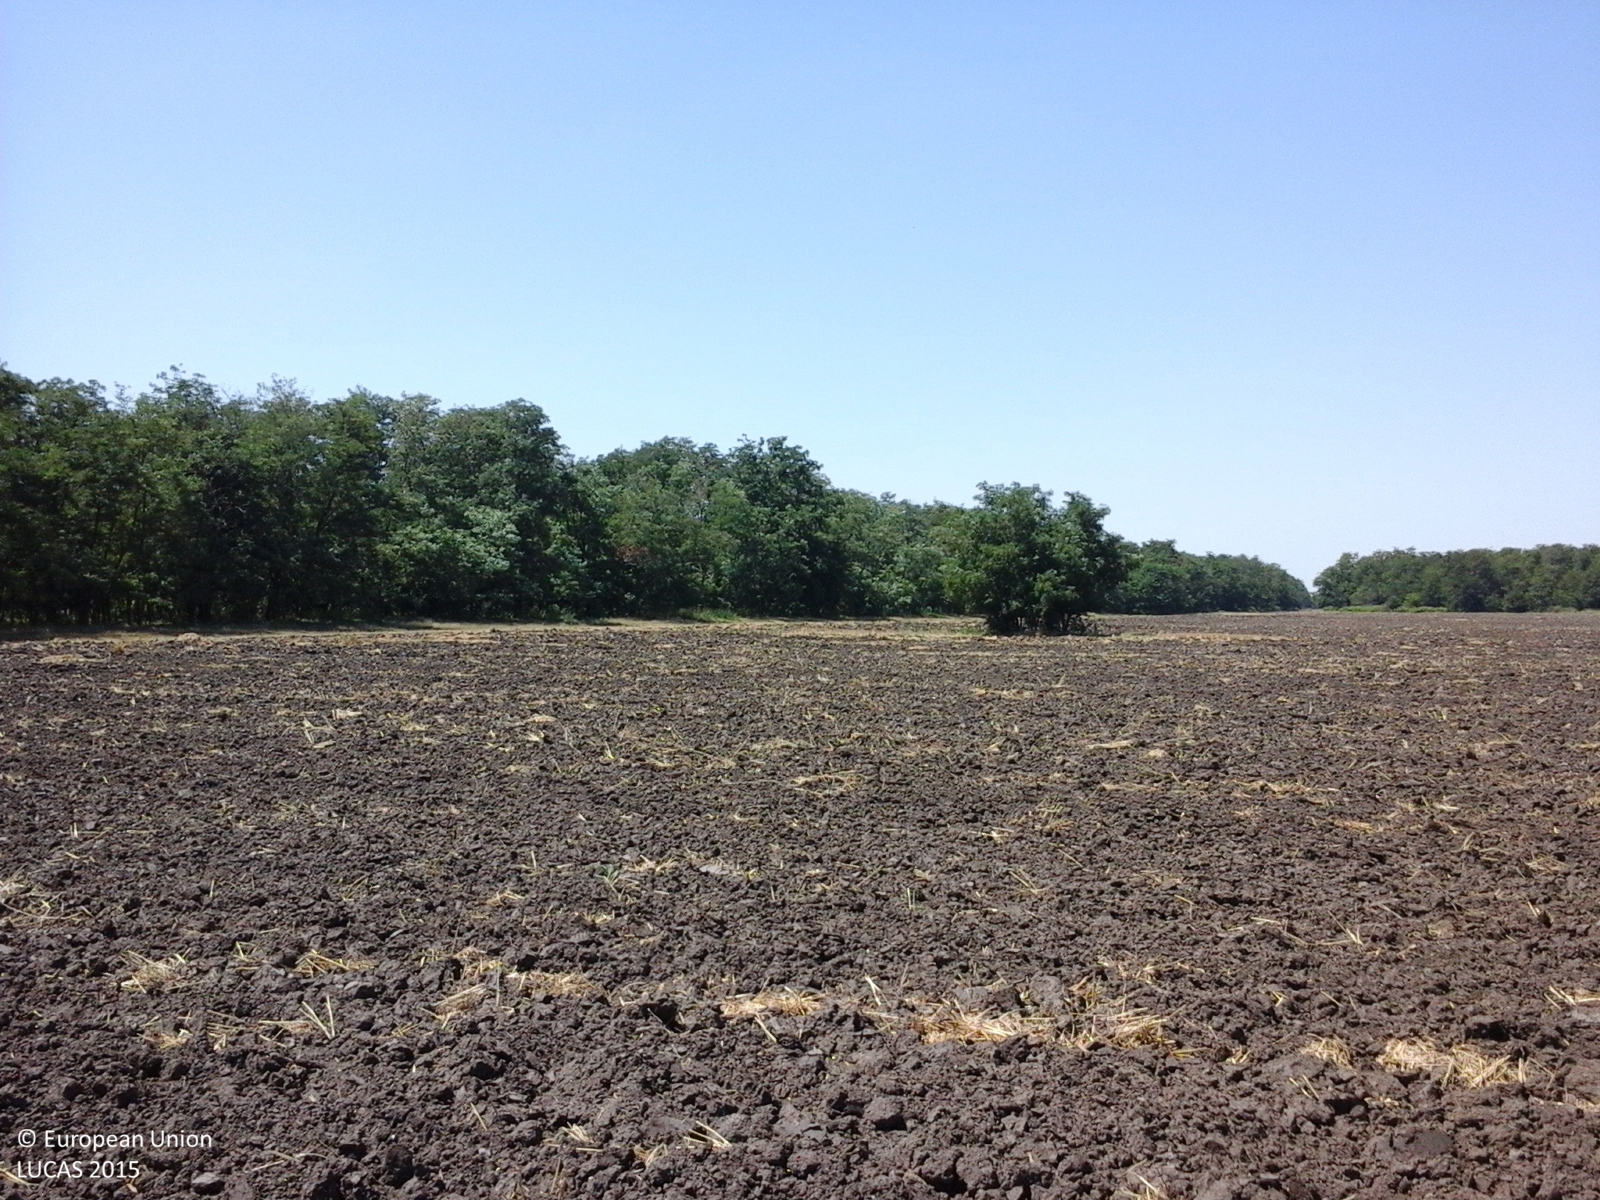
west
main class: Cropland
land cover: Common wheat
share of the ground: < 10 %
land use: Agriculture (excluding fallow land and kitchen gardens)
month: July
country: RO
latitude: 44.2817
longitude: 26.6446
